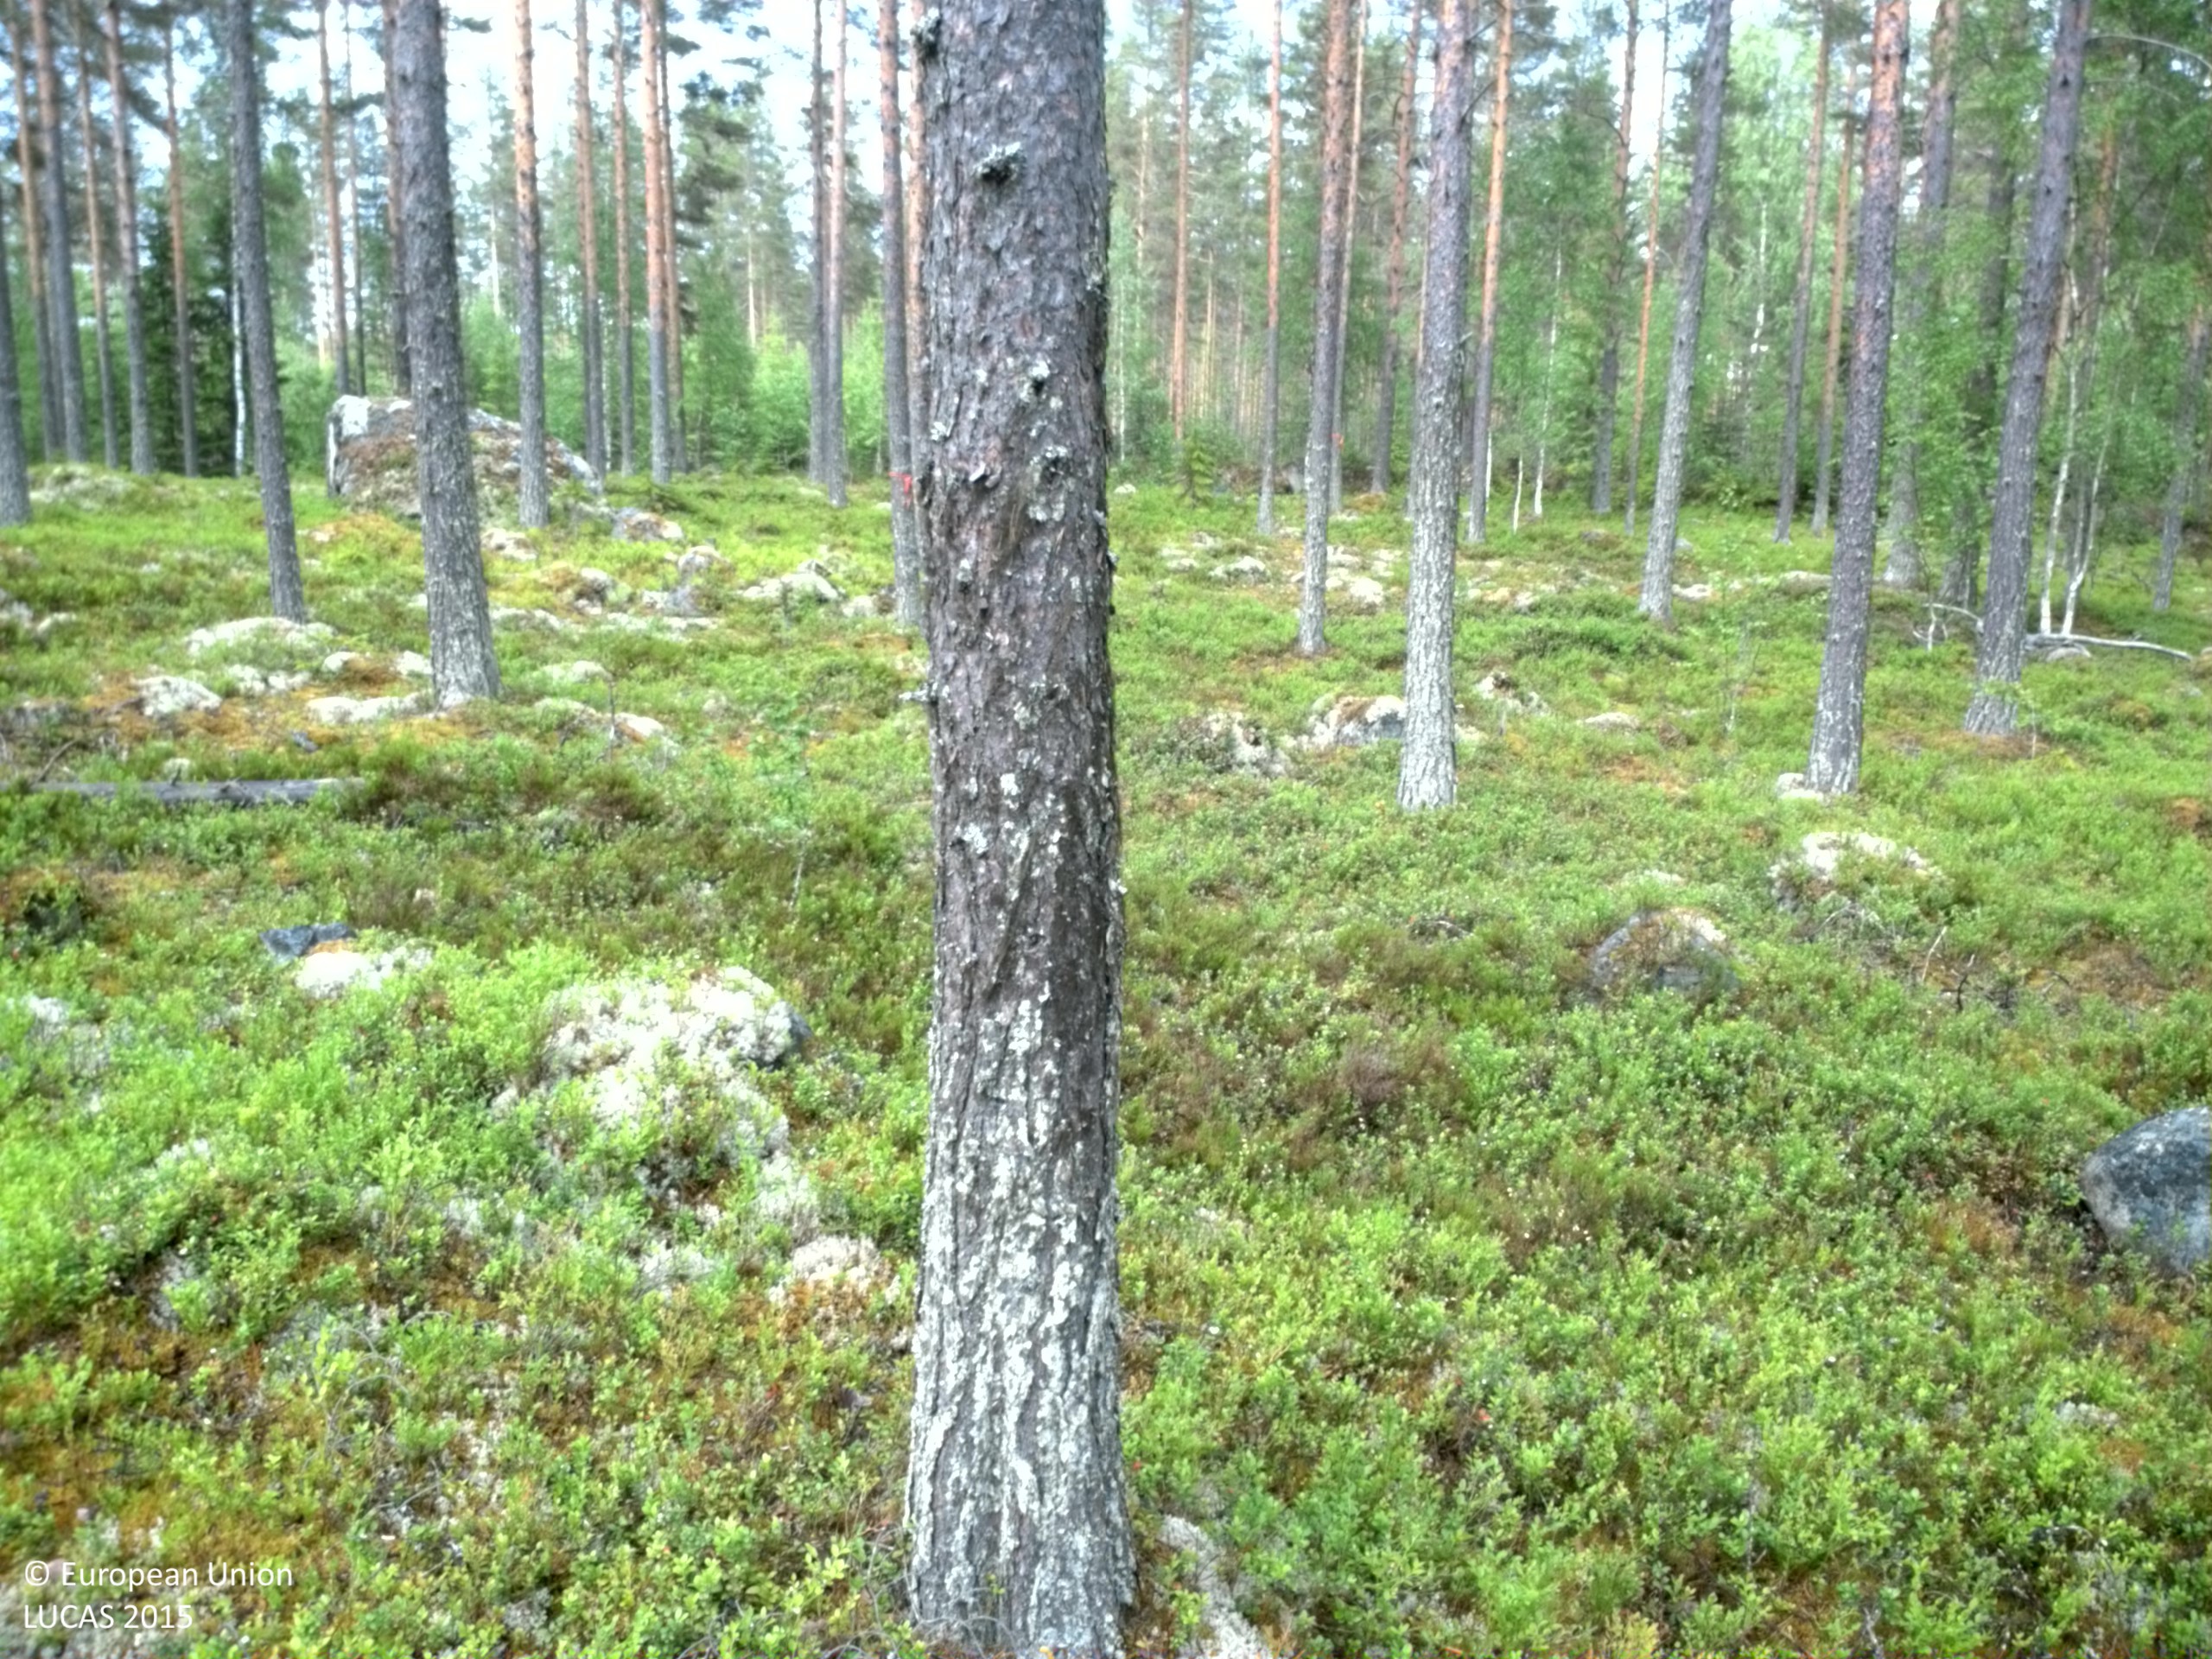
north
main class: Woodland
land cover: Pine dominated coniferous woodland
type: boreal forest
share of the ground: 50 - 75 %
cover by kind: coniferous forest trees 75 %, lichens and mosses 15 %, shrubs 10 %
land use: Forestry
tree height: > 5 m
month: July
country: SE
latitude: 63.2284
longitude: 17.7567
